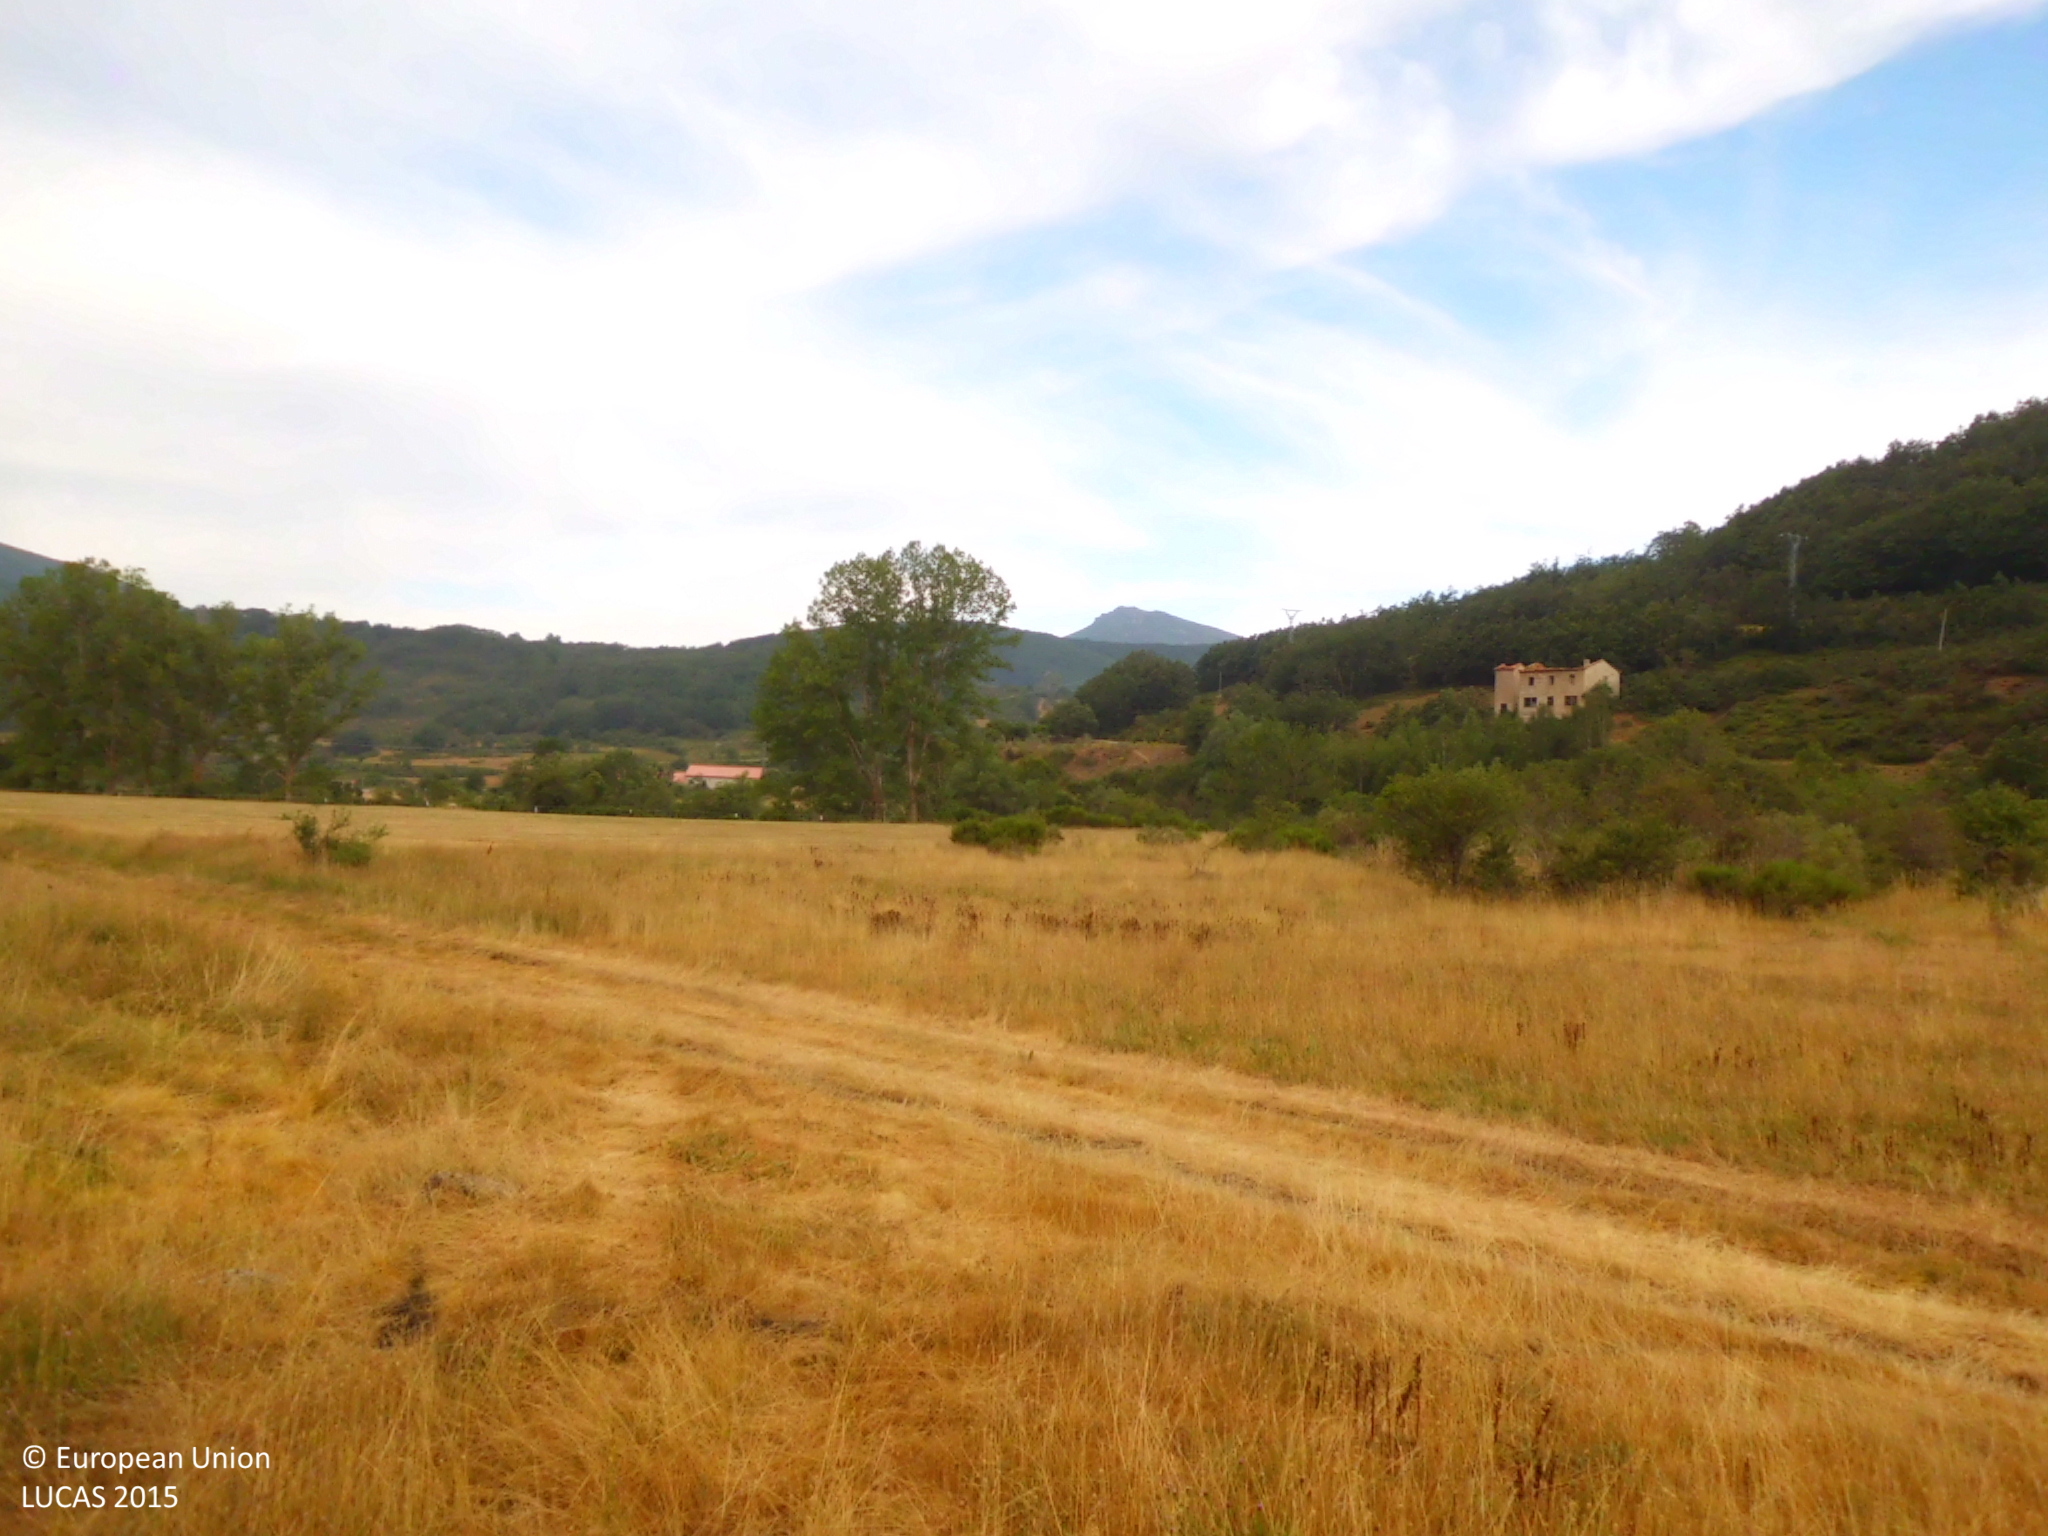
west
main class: Grassland
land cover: Grassland without tree/shrub cover
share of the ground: > 75 %
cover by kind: herbaceous plants 100 %
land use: Agriculture (excluding fallow land and kitchen gardens)
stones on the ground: 25 - 50 %
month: July
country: ES
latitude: 42.9795
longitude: -4.4892
